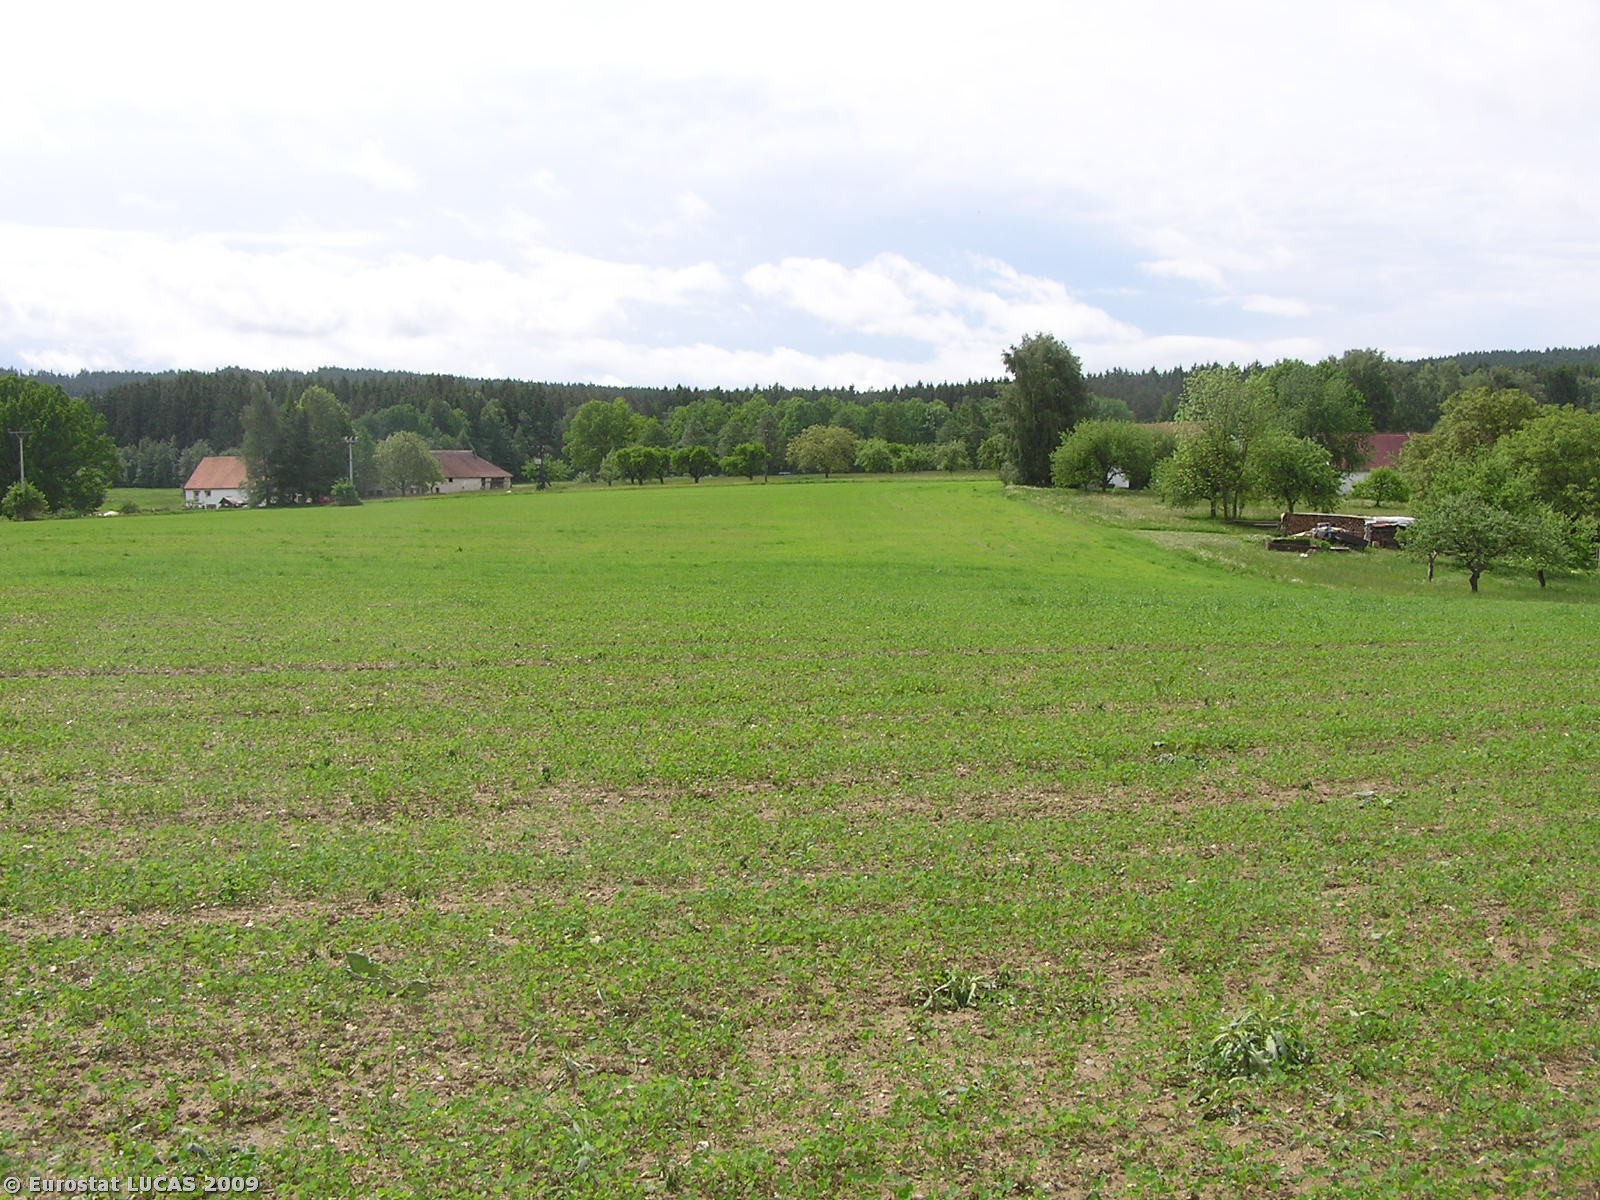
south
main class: Cropland
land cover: Clovers
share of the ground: 50 - 75 %
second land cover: Mixed cereals for fodder
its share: 25 - 50 %
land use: Agriculture (excluding fallow land and kitchen gardens)
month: May
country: CZ
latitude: 49.4089
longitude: 14.9778
